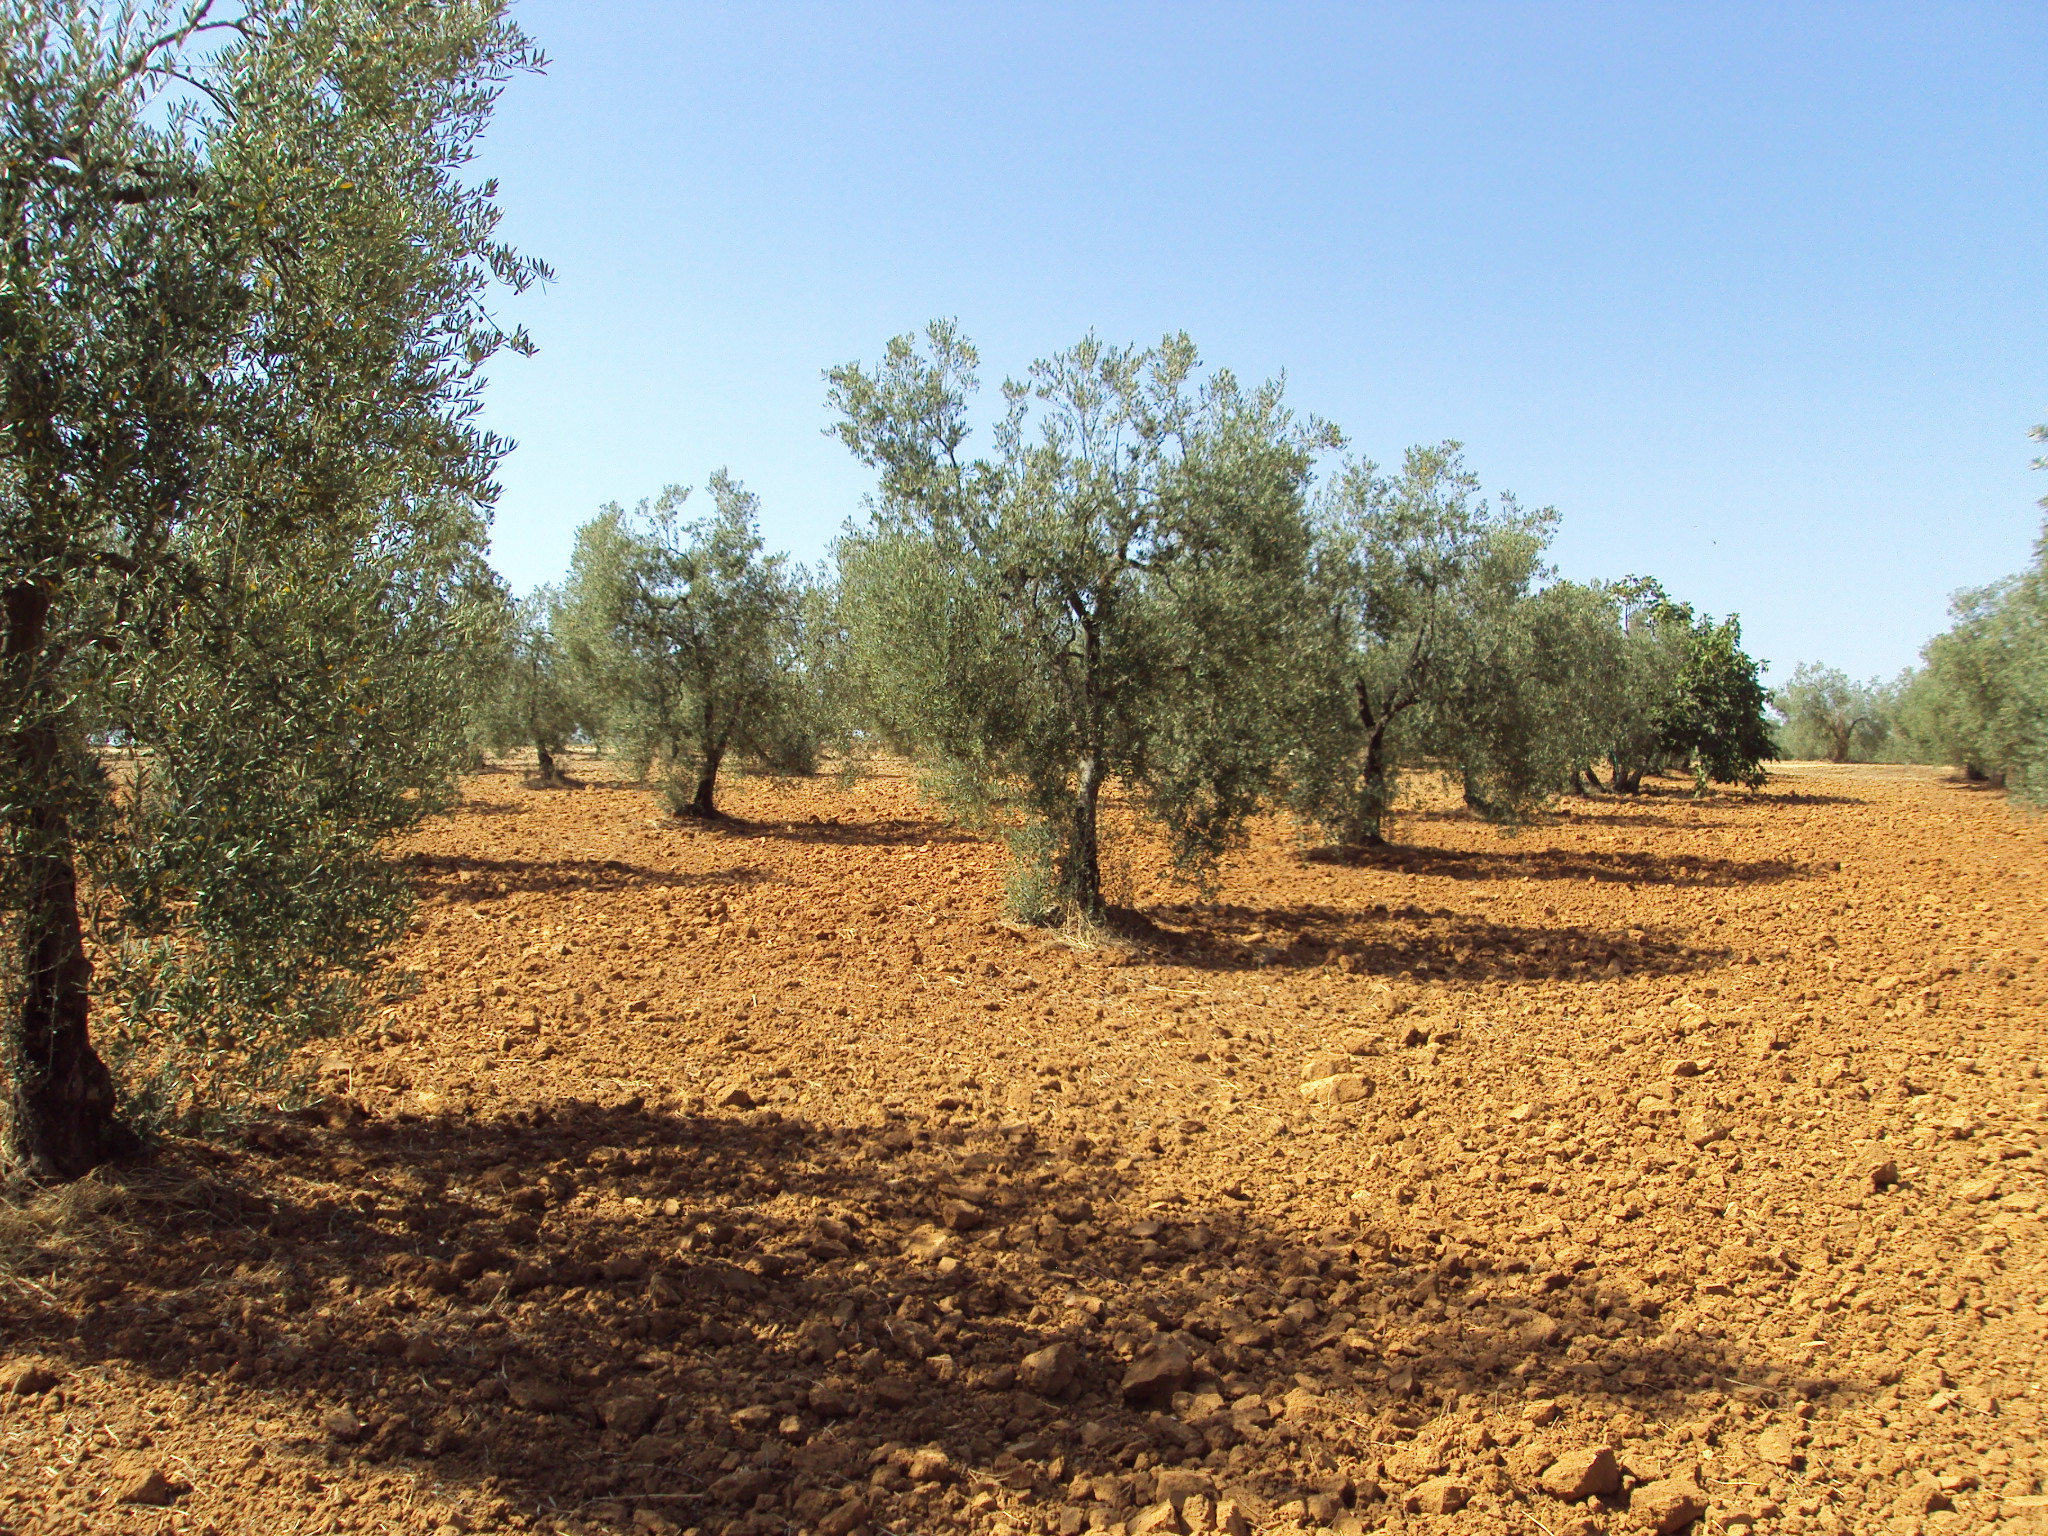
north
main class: Cropland
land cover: Olive groves
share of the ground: 50 - 75 %
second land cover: Other bare soil
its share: > 75 %
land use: Agriculture (excluding fallow land and kitchen gardens)
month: July
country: ES
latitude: 37.2902
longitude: -6.5108
